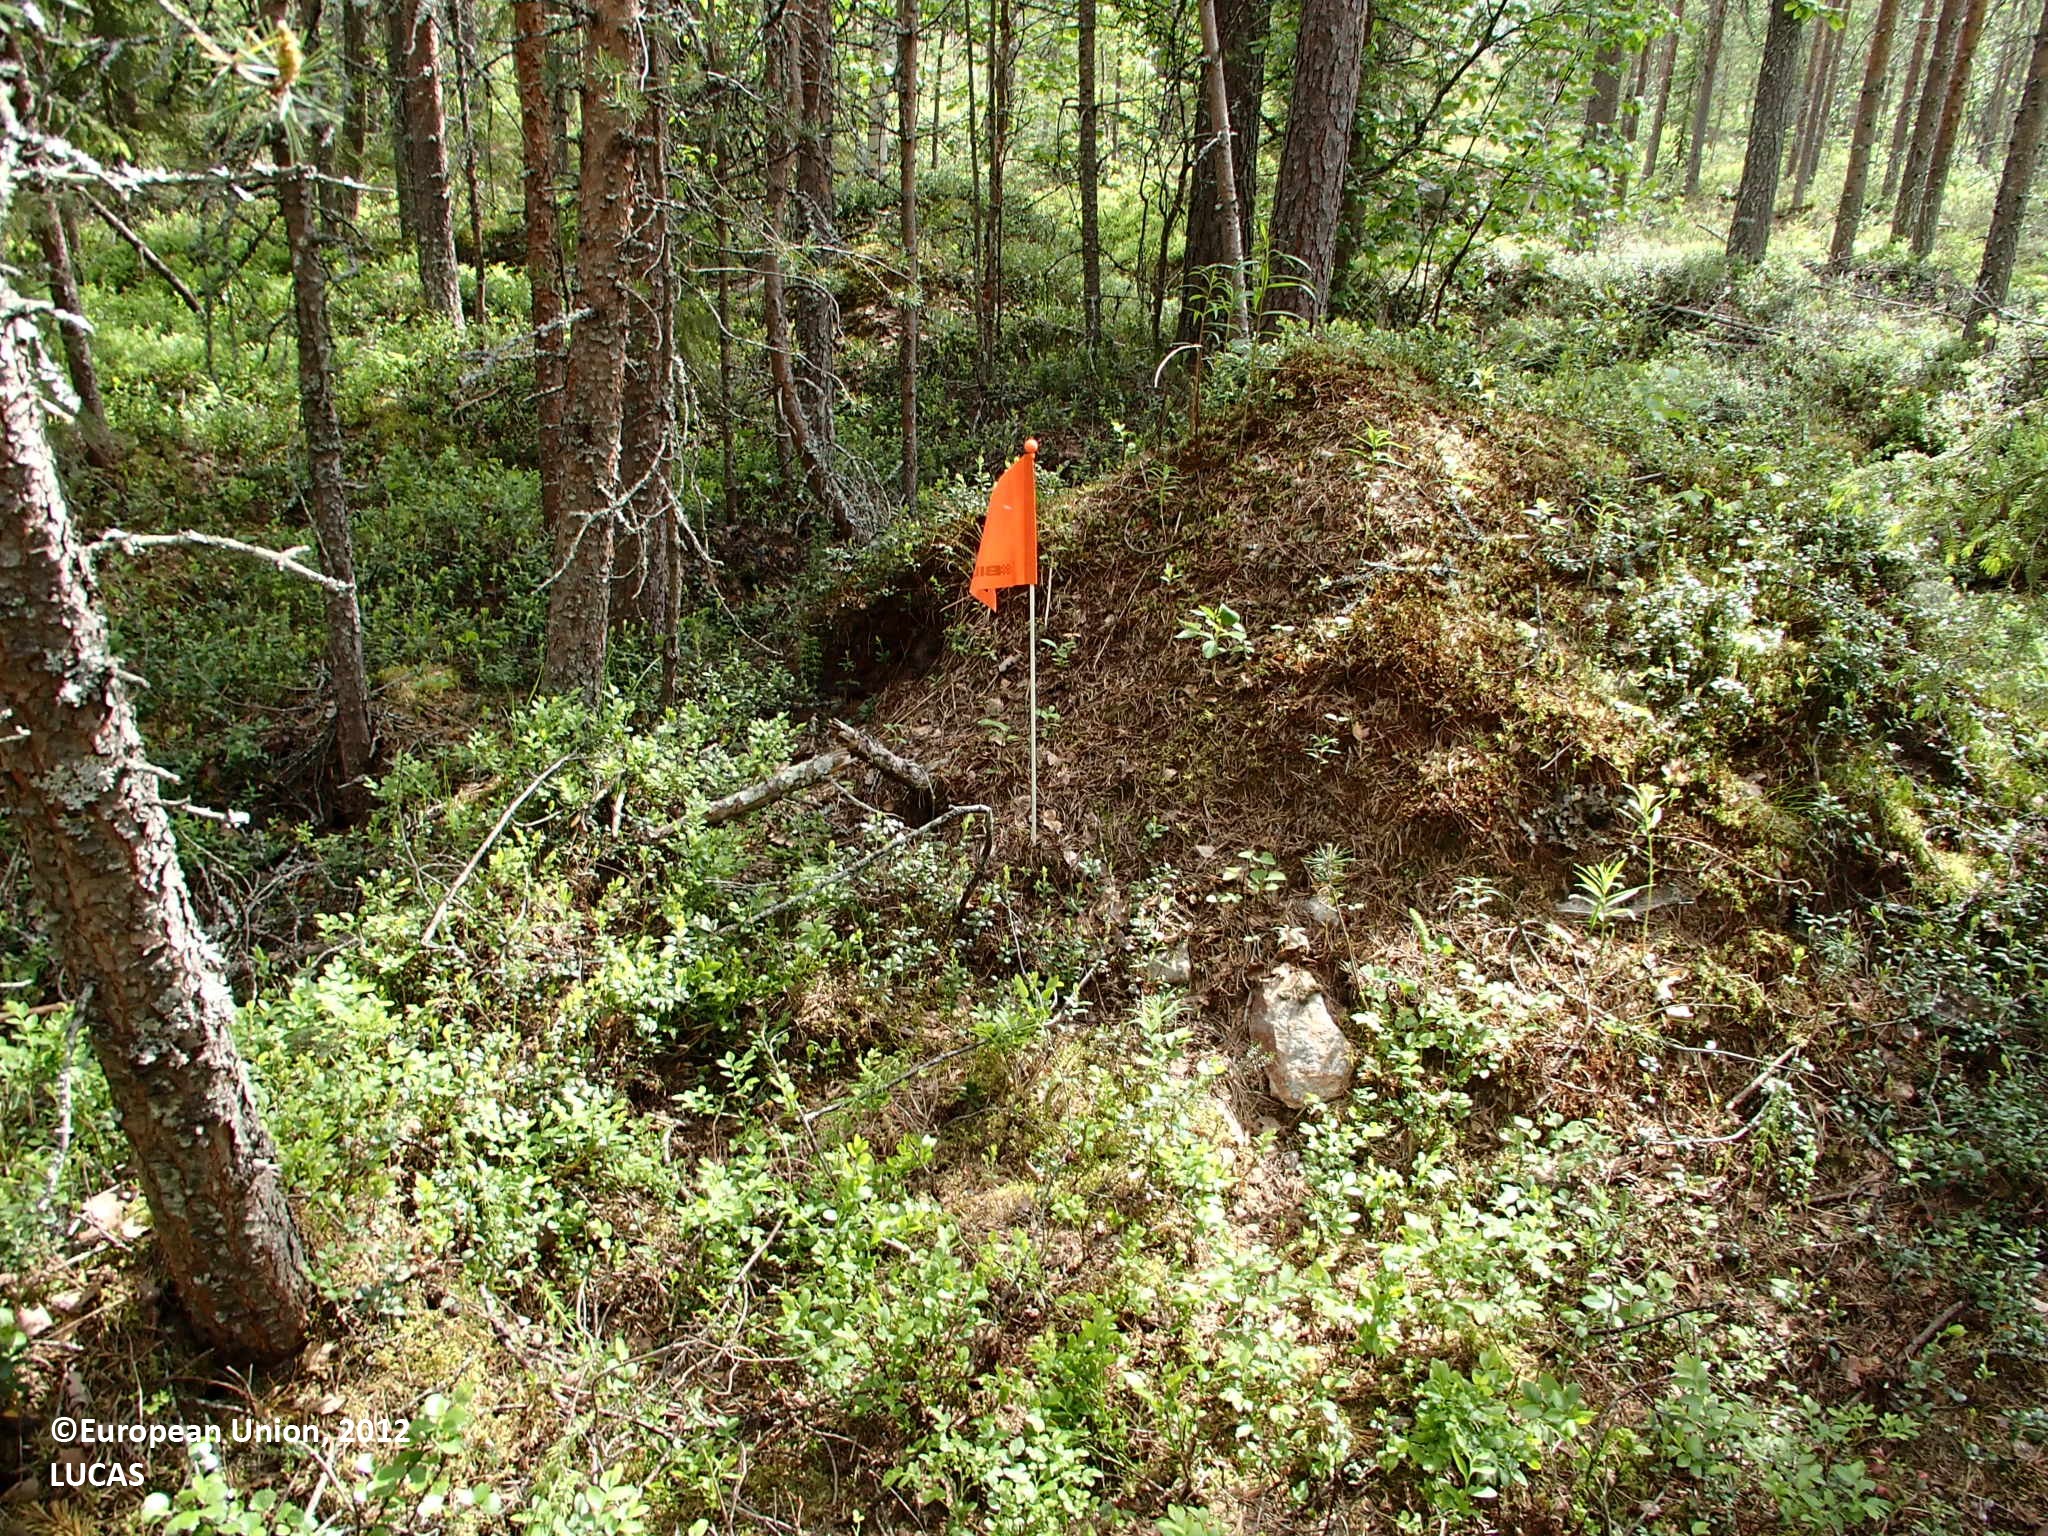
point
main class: Woodland
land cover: Pine dominated coniferous woodland
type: boreal forest
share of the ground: > 75 %
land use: Forestry
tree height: > 5 m
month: June
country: FI
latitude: 66.6041
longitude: 26.3535
